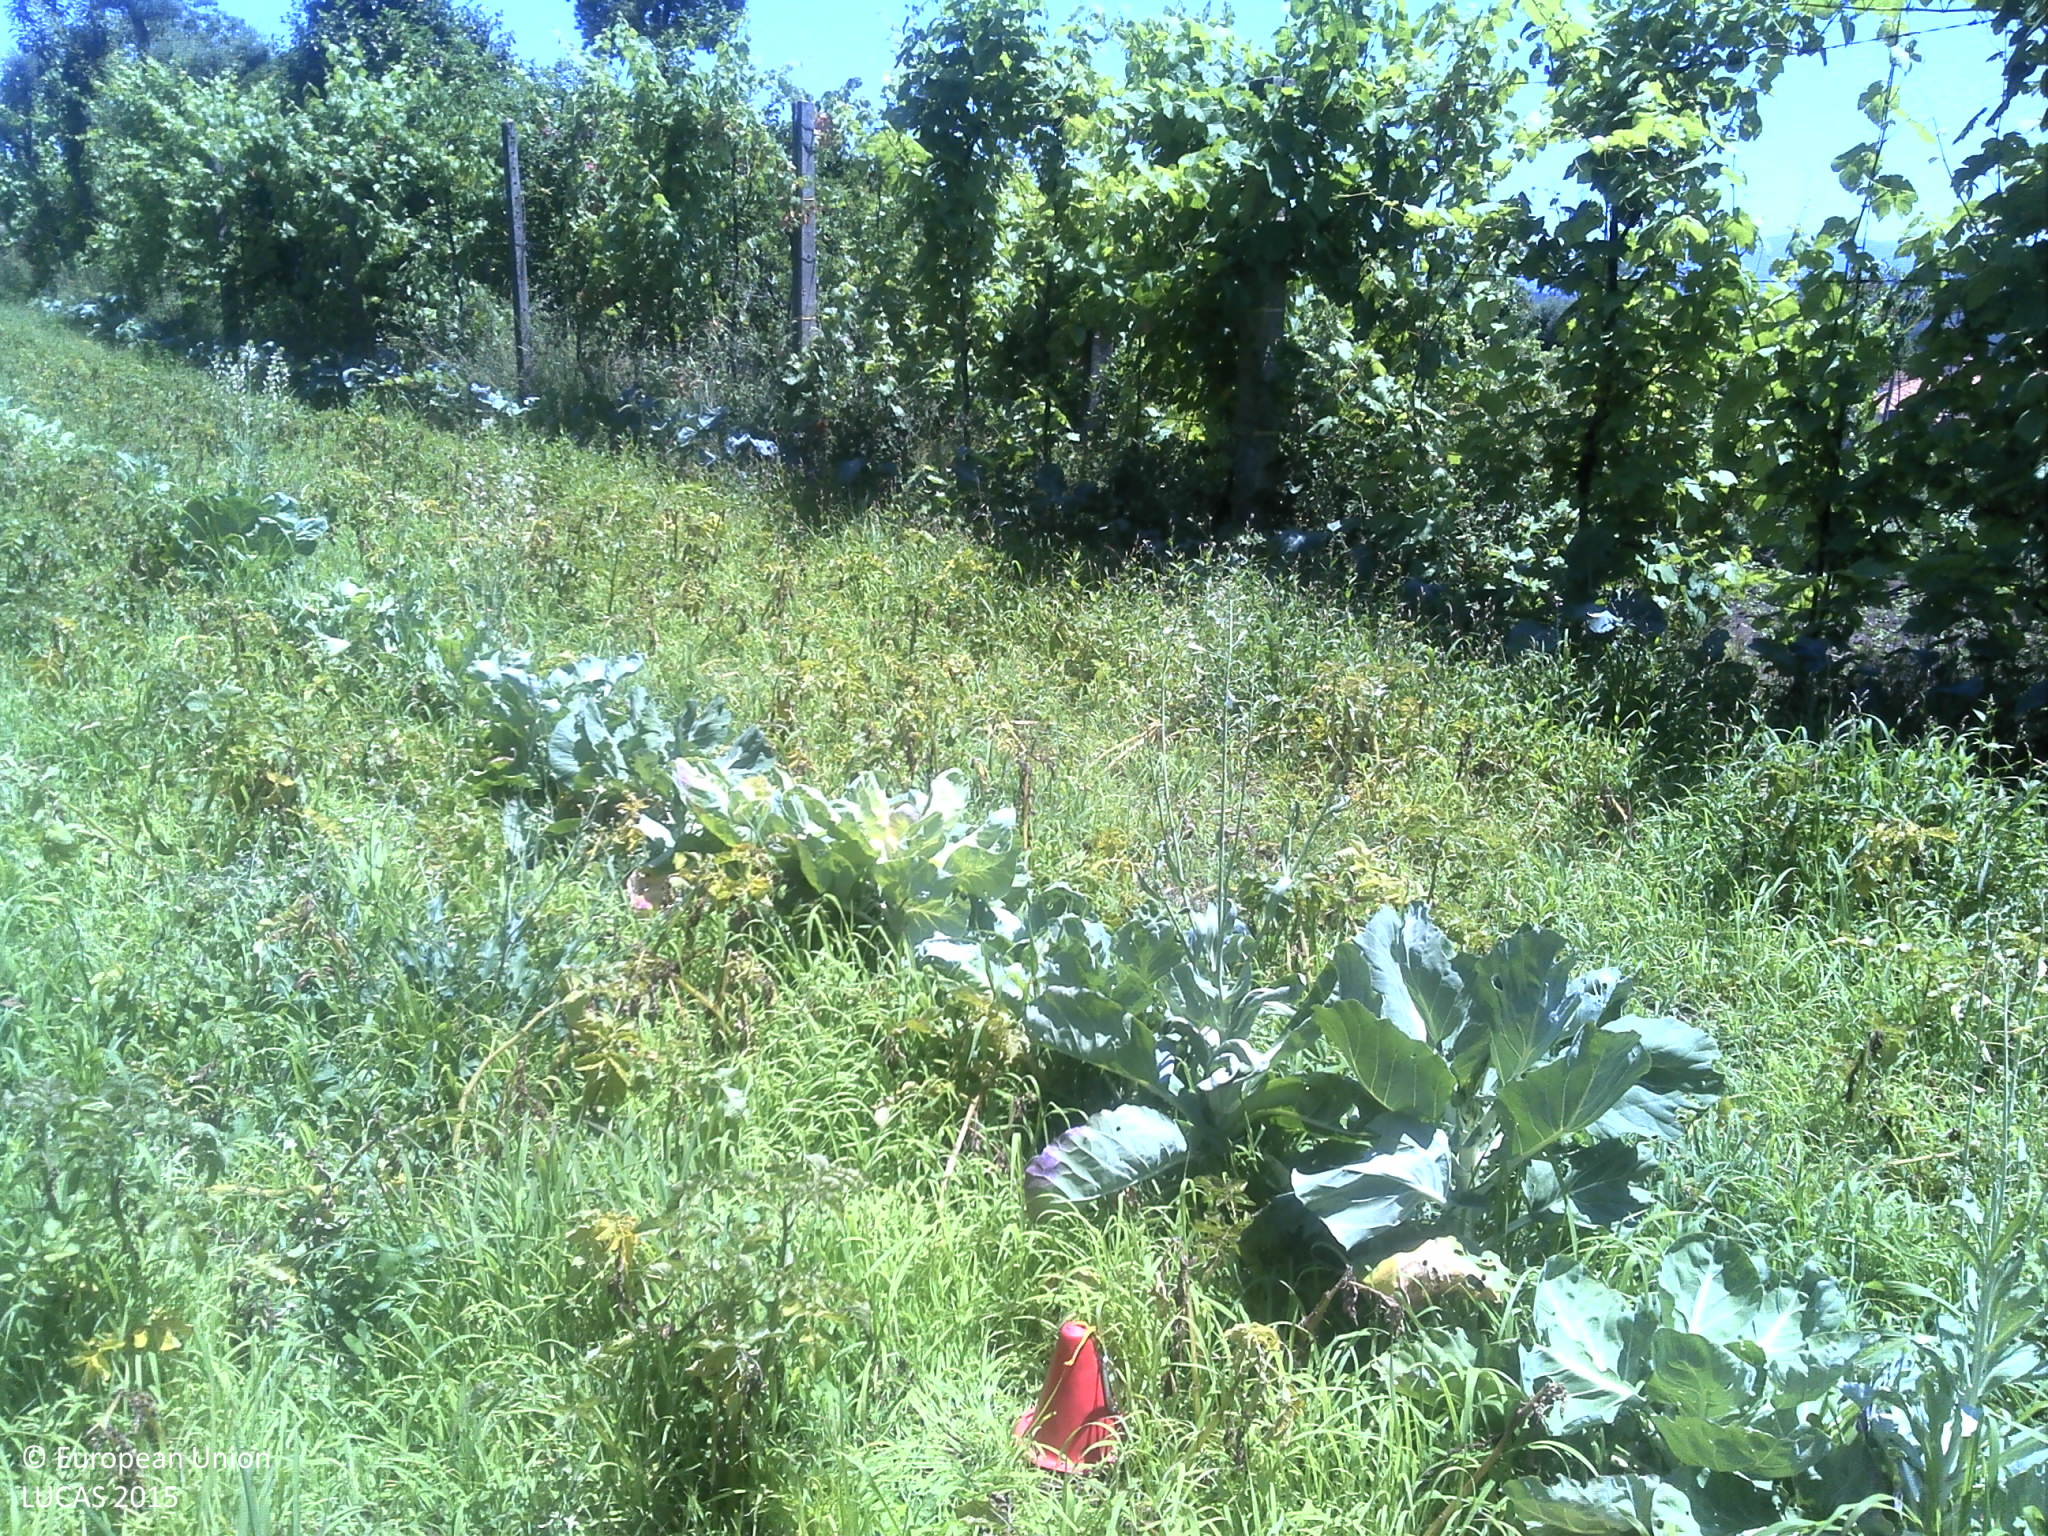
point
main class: Cropland
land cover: Other fresh vegetables
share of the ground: > 75 %
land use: Kitchen garden
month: June
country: PT
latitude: 41.5536
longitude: -8.3393
